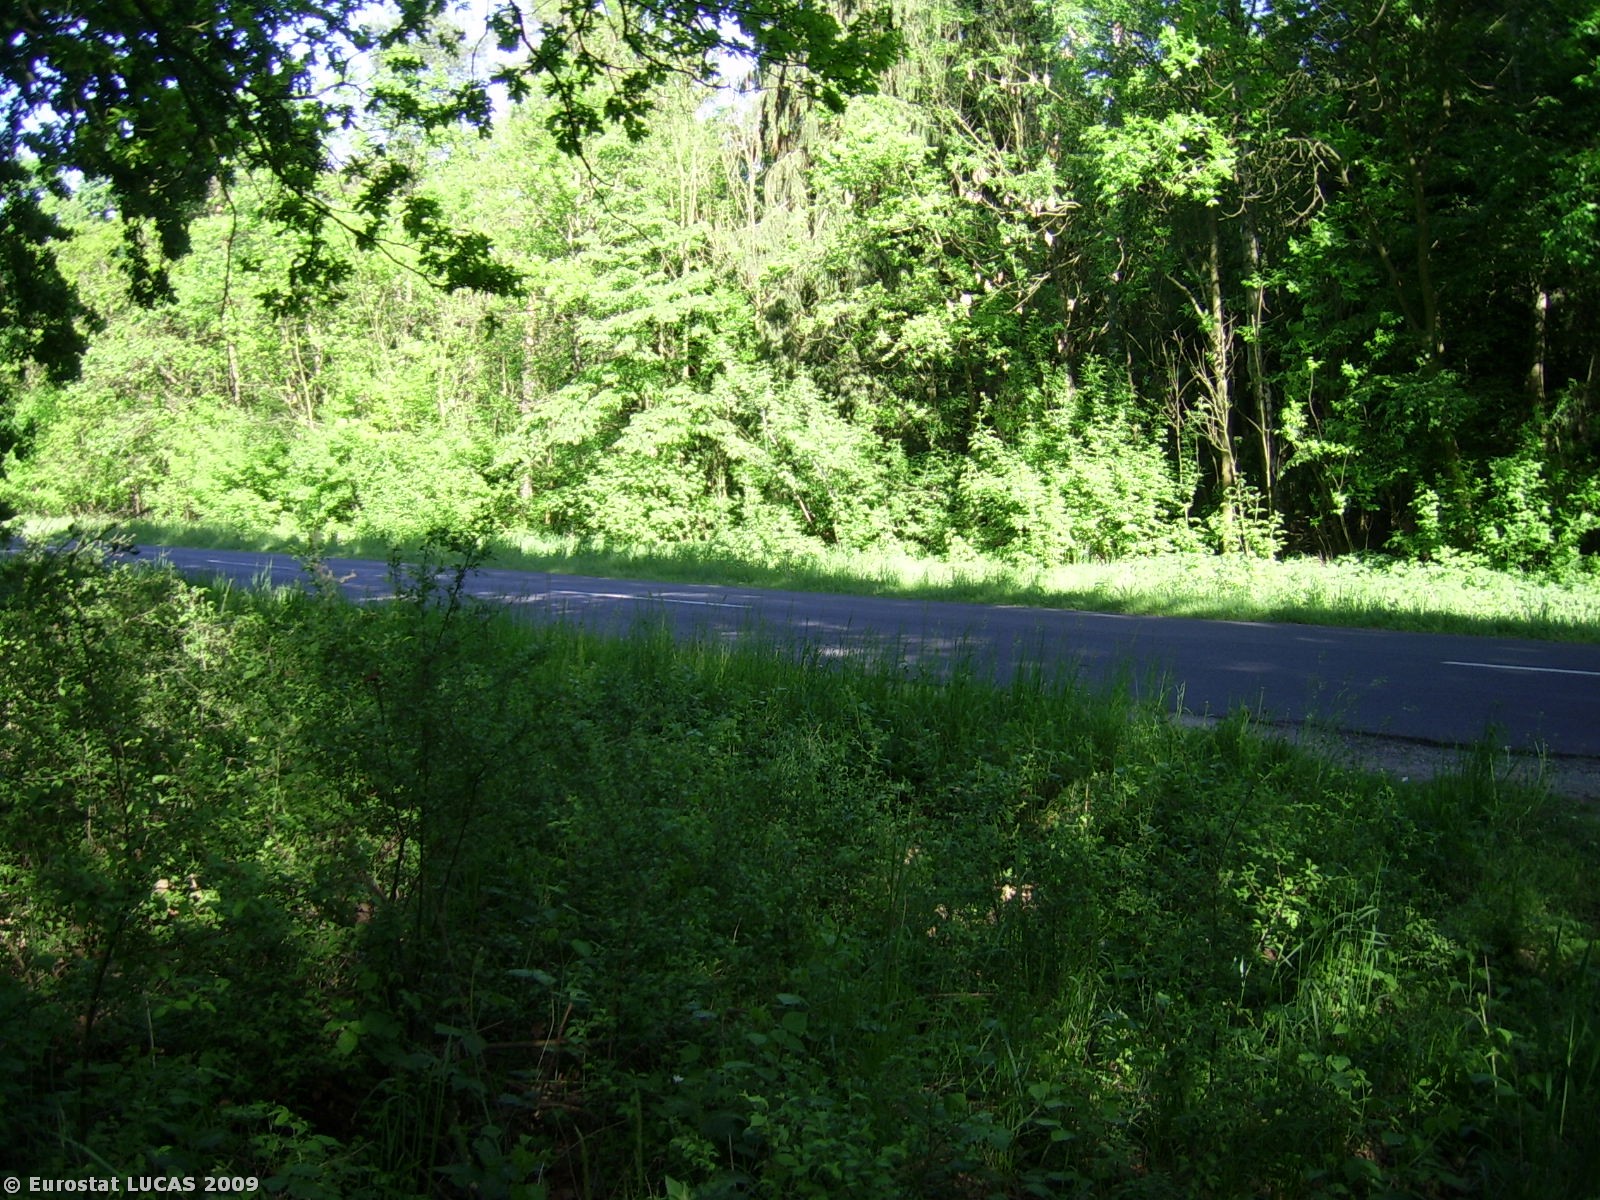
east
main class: Woodland
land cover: Coniferous woodland
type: hemiboreal forest and nemoral coniferous forest and mixed broadleaved-coniferous forest
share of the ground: > 75 %
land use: Forestry
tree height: > 5 m
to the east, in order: Coniferous woodland; Tracks; Coniferous woodland
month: May
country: PL
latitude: 51.7834
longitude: 16.8368
